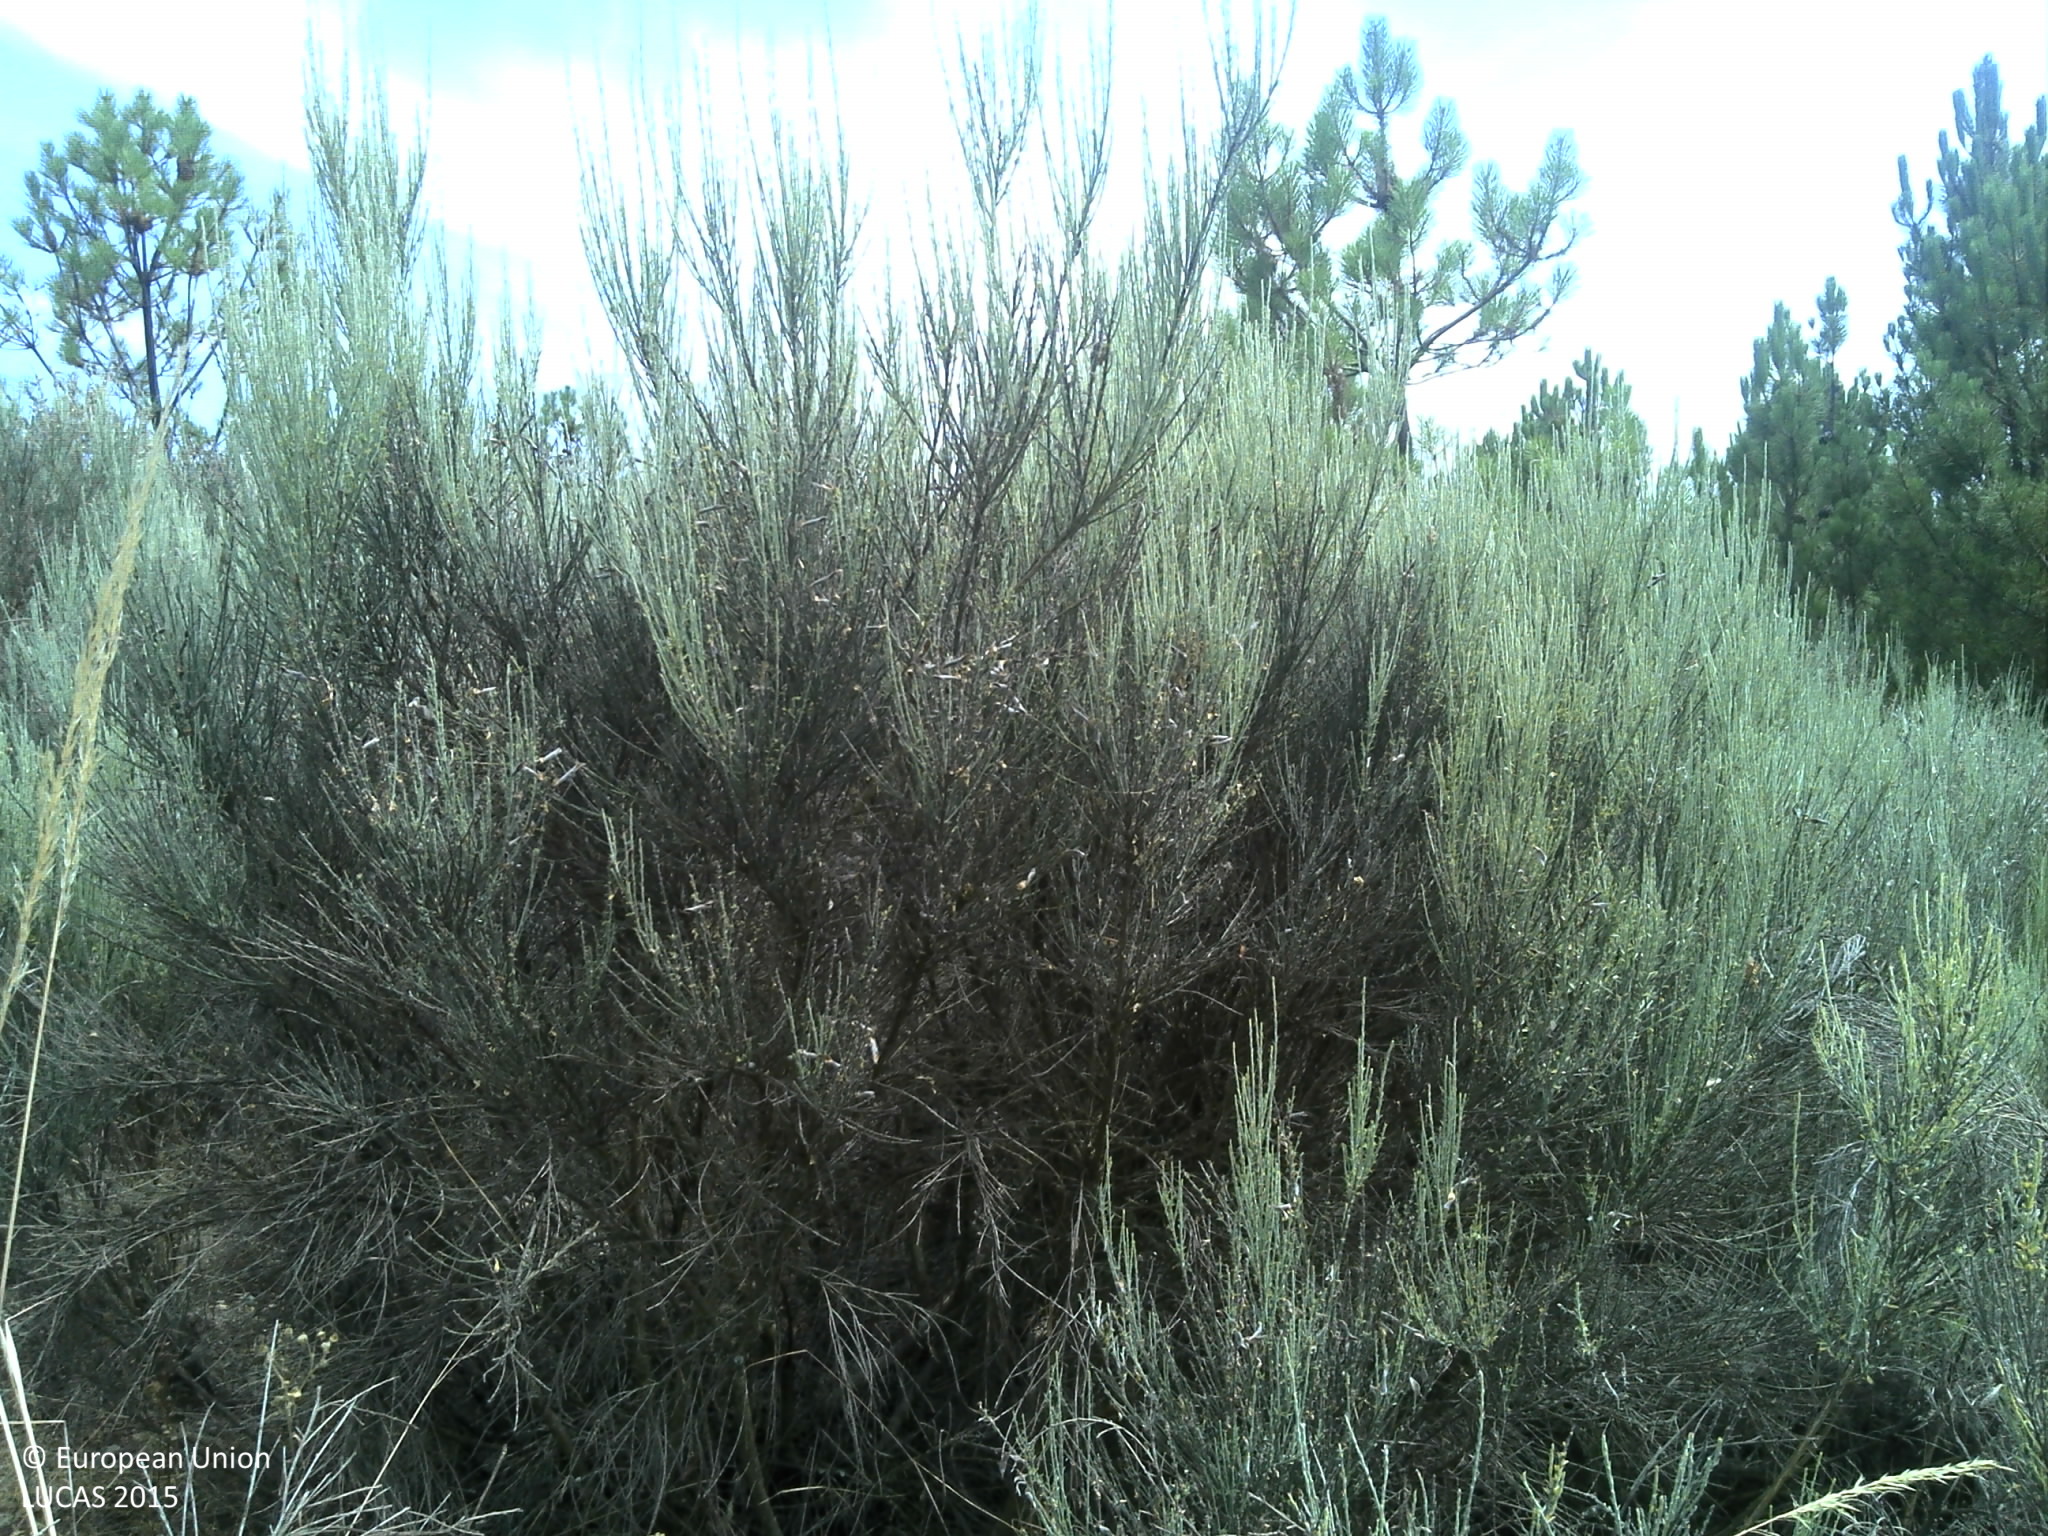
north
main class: Woodland
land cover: Pine dominated coniferous woodland
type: coniferous forest of the mediterranean region
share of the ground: 50 - 75 %
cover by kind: coniferous forest trees 50 %, shrubs 50 %
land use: Forestry
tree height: > 5 m
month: July
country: PT
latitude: 40.9405
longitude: -7.3492
